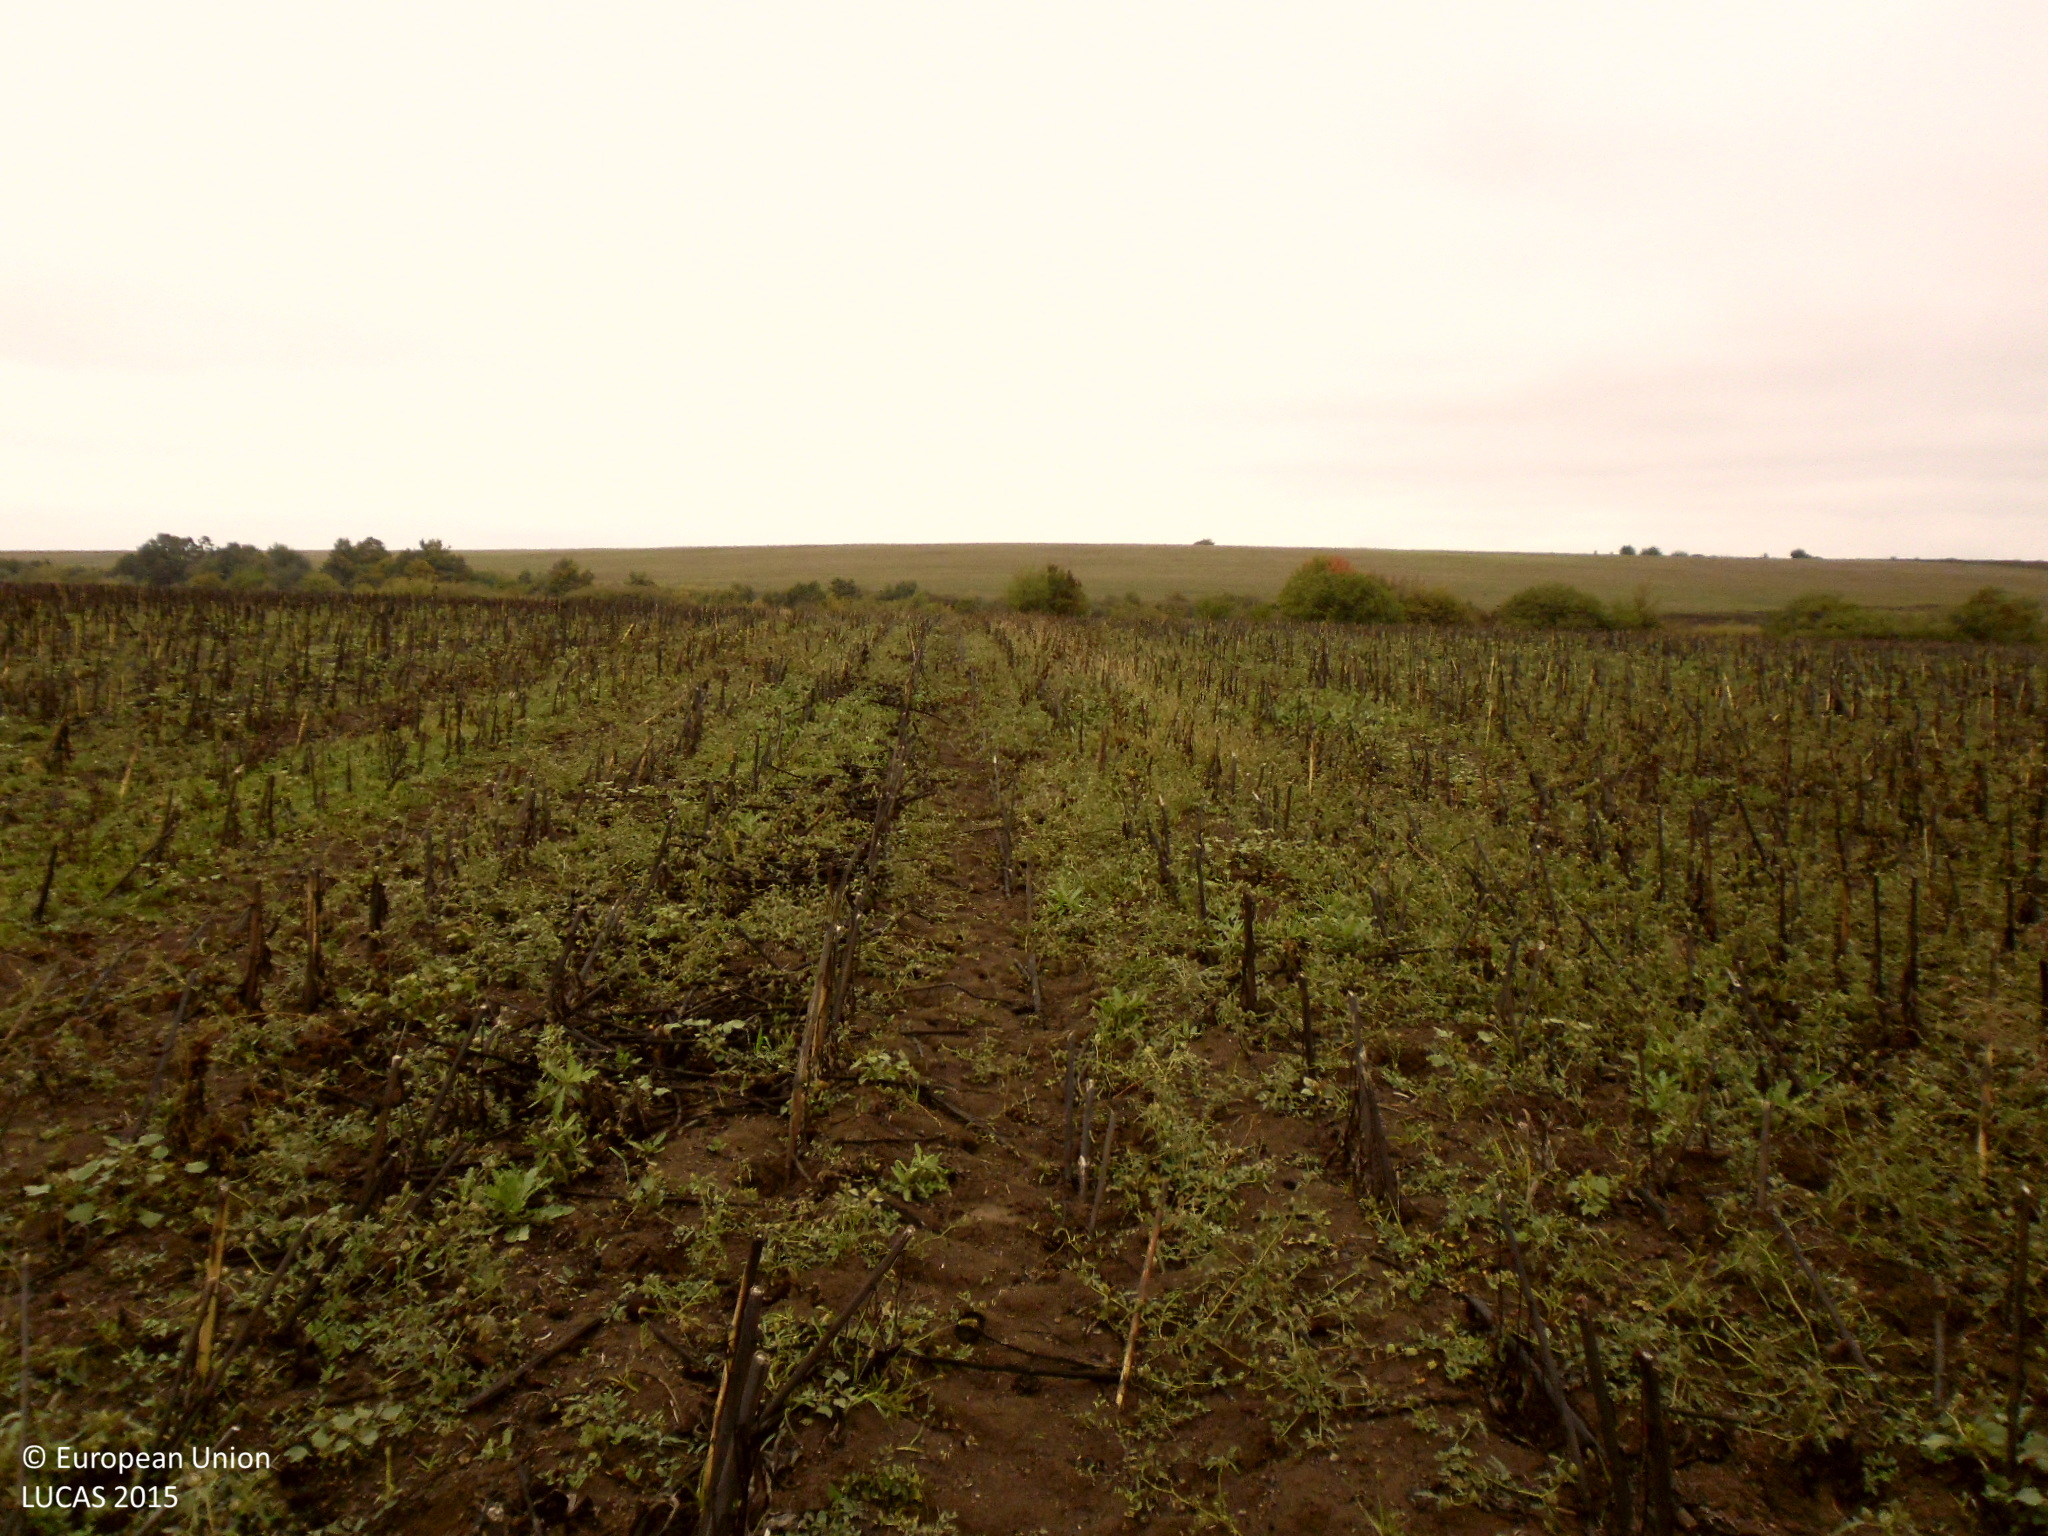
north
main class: Cropland
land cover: Sunflower
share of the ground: 10 - 25 %
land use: Agriculture (excluding fallow land and kitchen gardens)
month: October
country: BG
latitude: 43.6788
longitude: 22.8249
